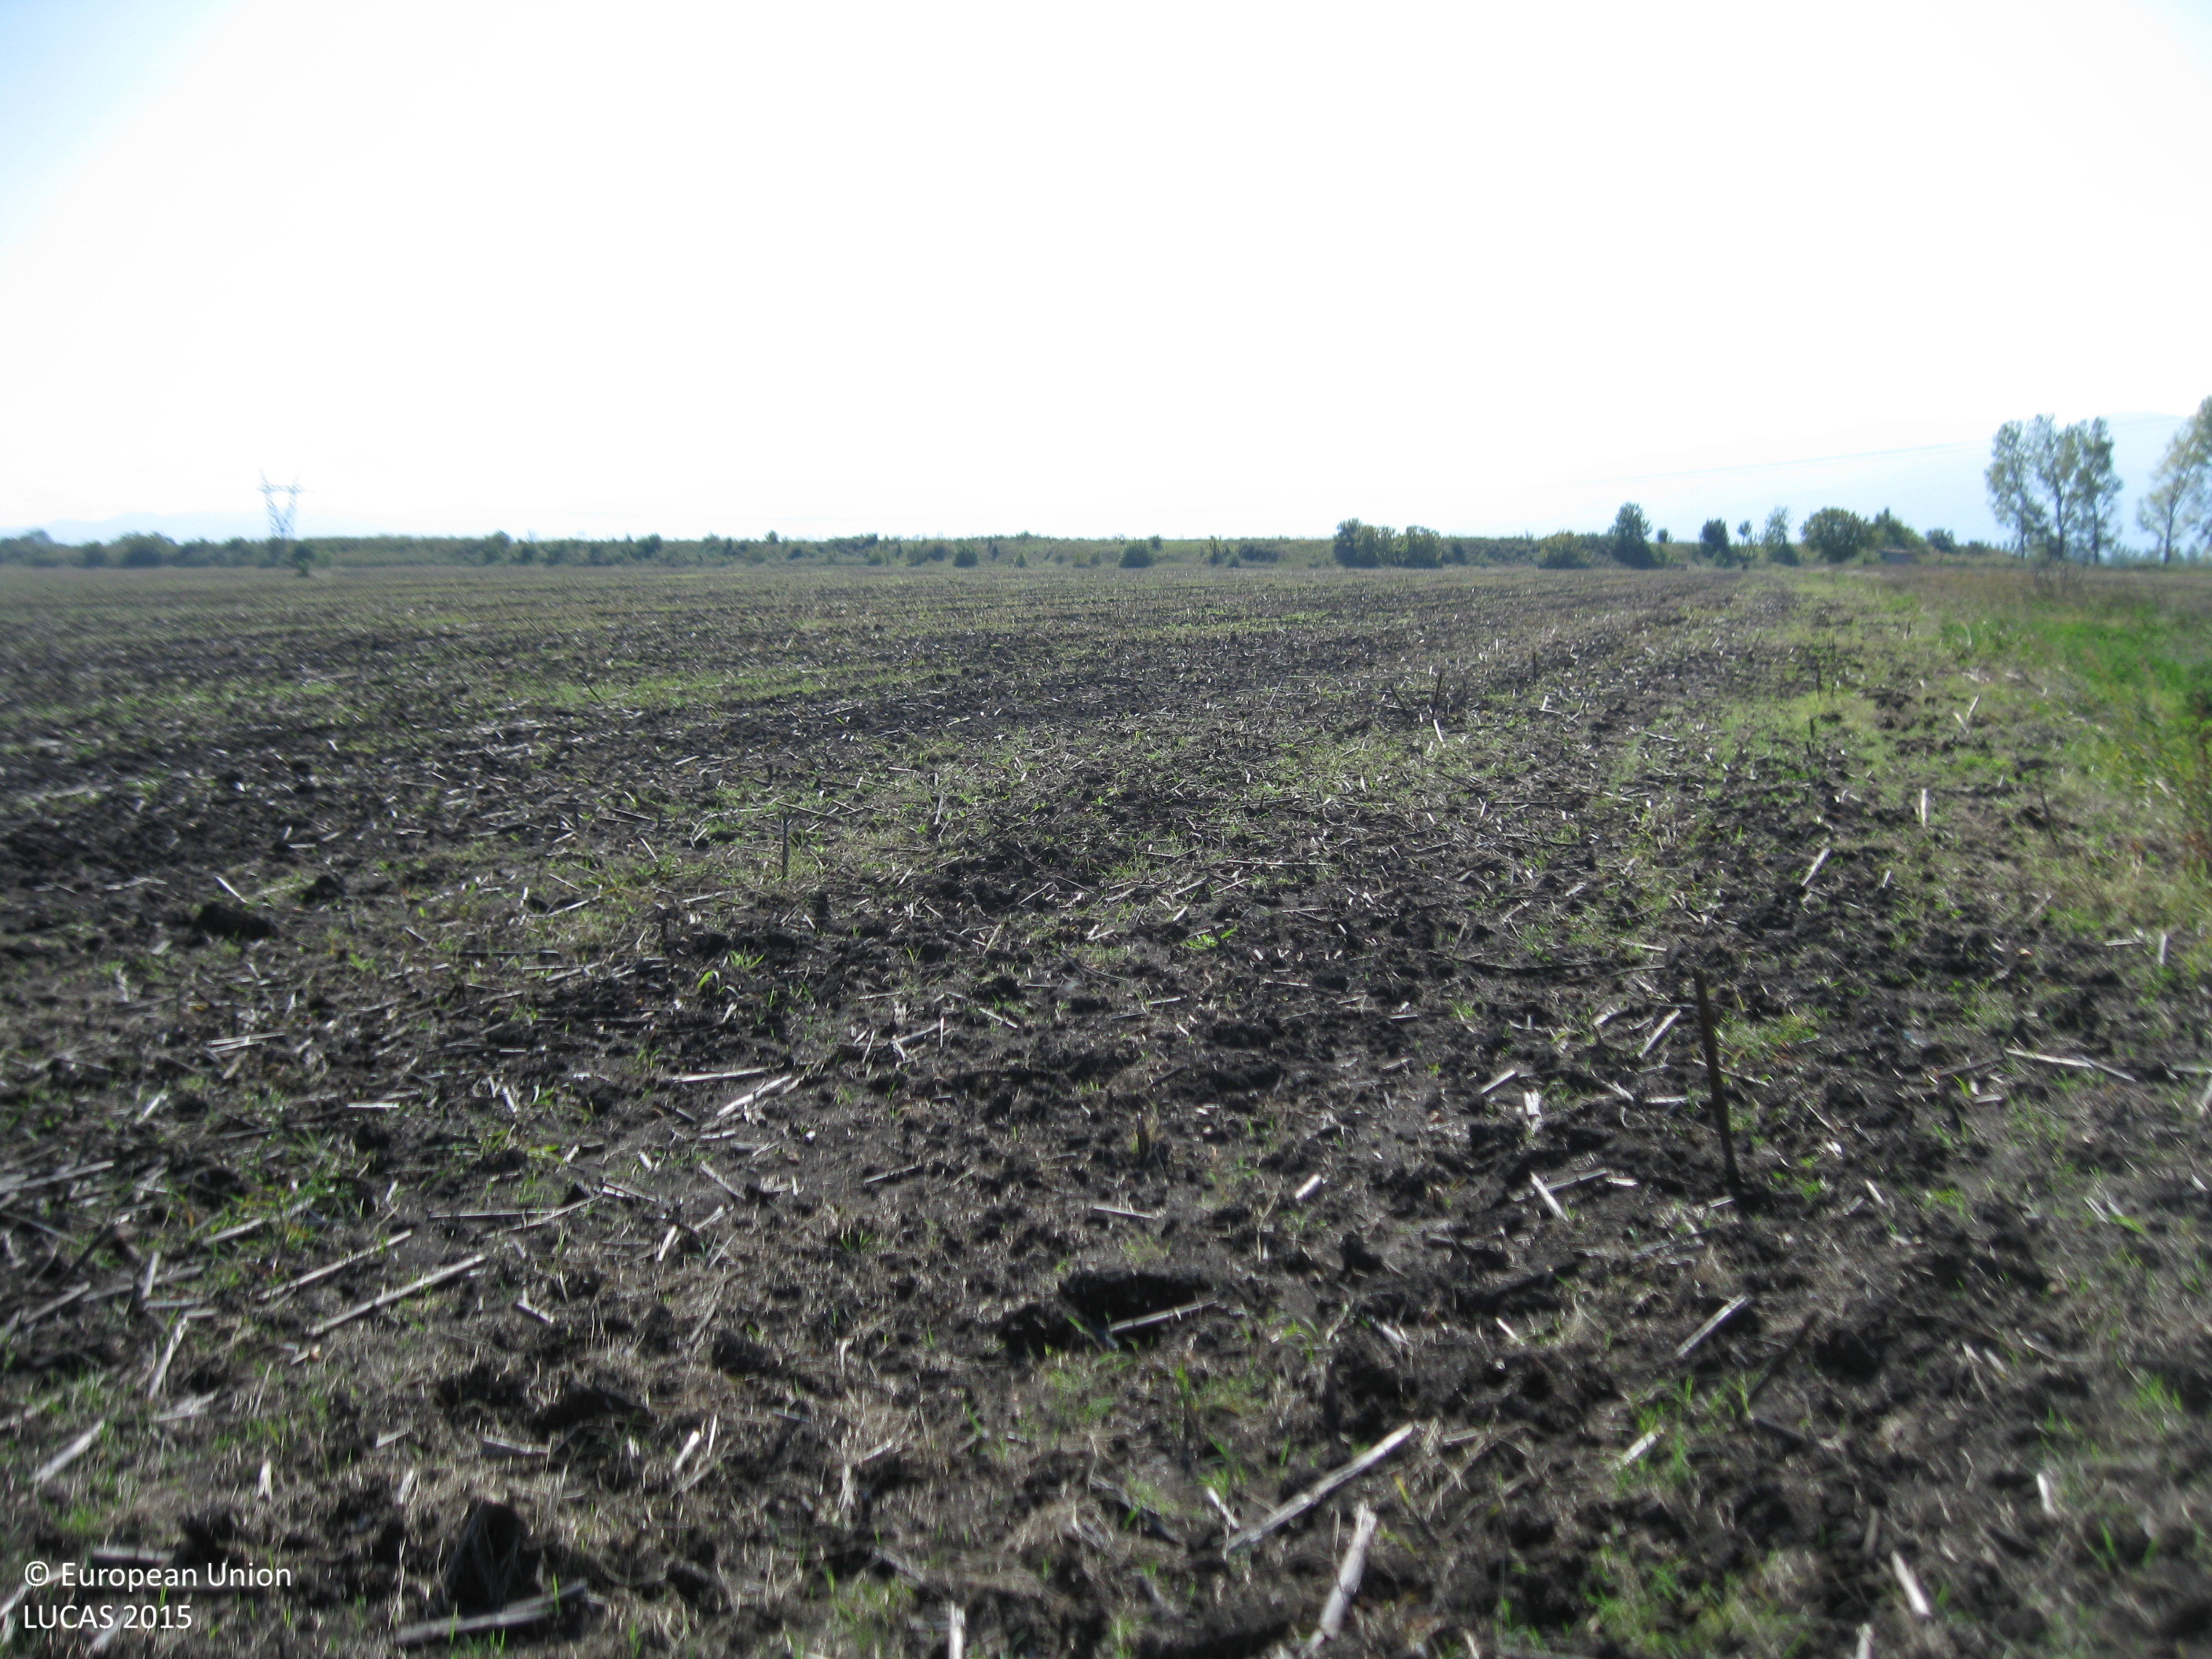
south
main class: Cropland
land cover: Sunflower
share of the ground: 10 - 25 %
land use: Agriculture (excluding fallow land and kitchen gardens)
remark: Harvested field
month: October
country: BG
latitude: 42.1035
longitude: 24.9648
